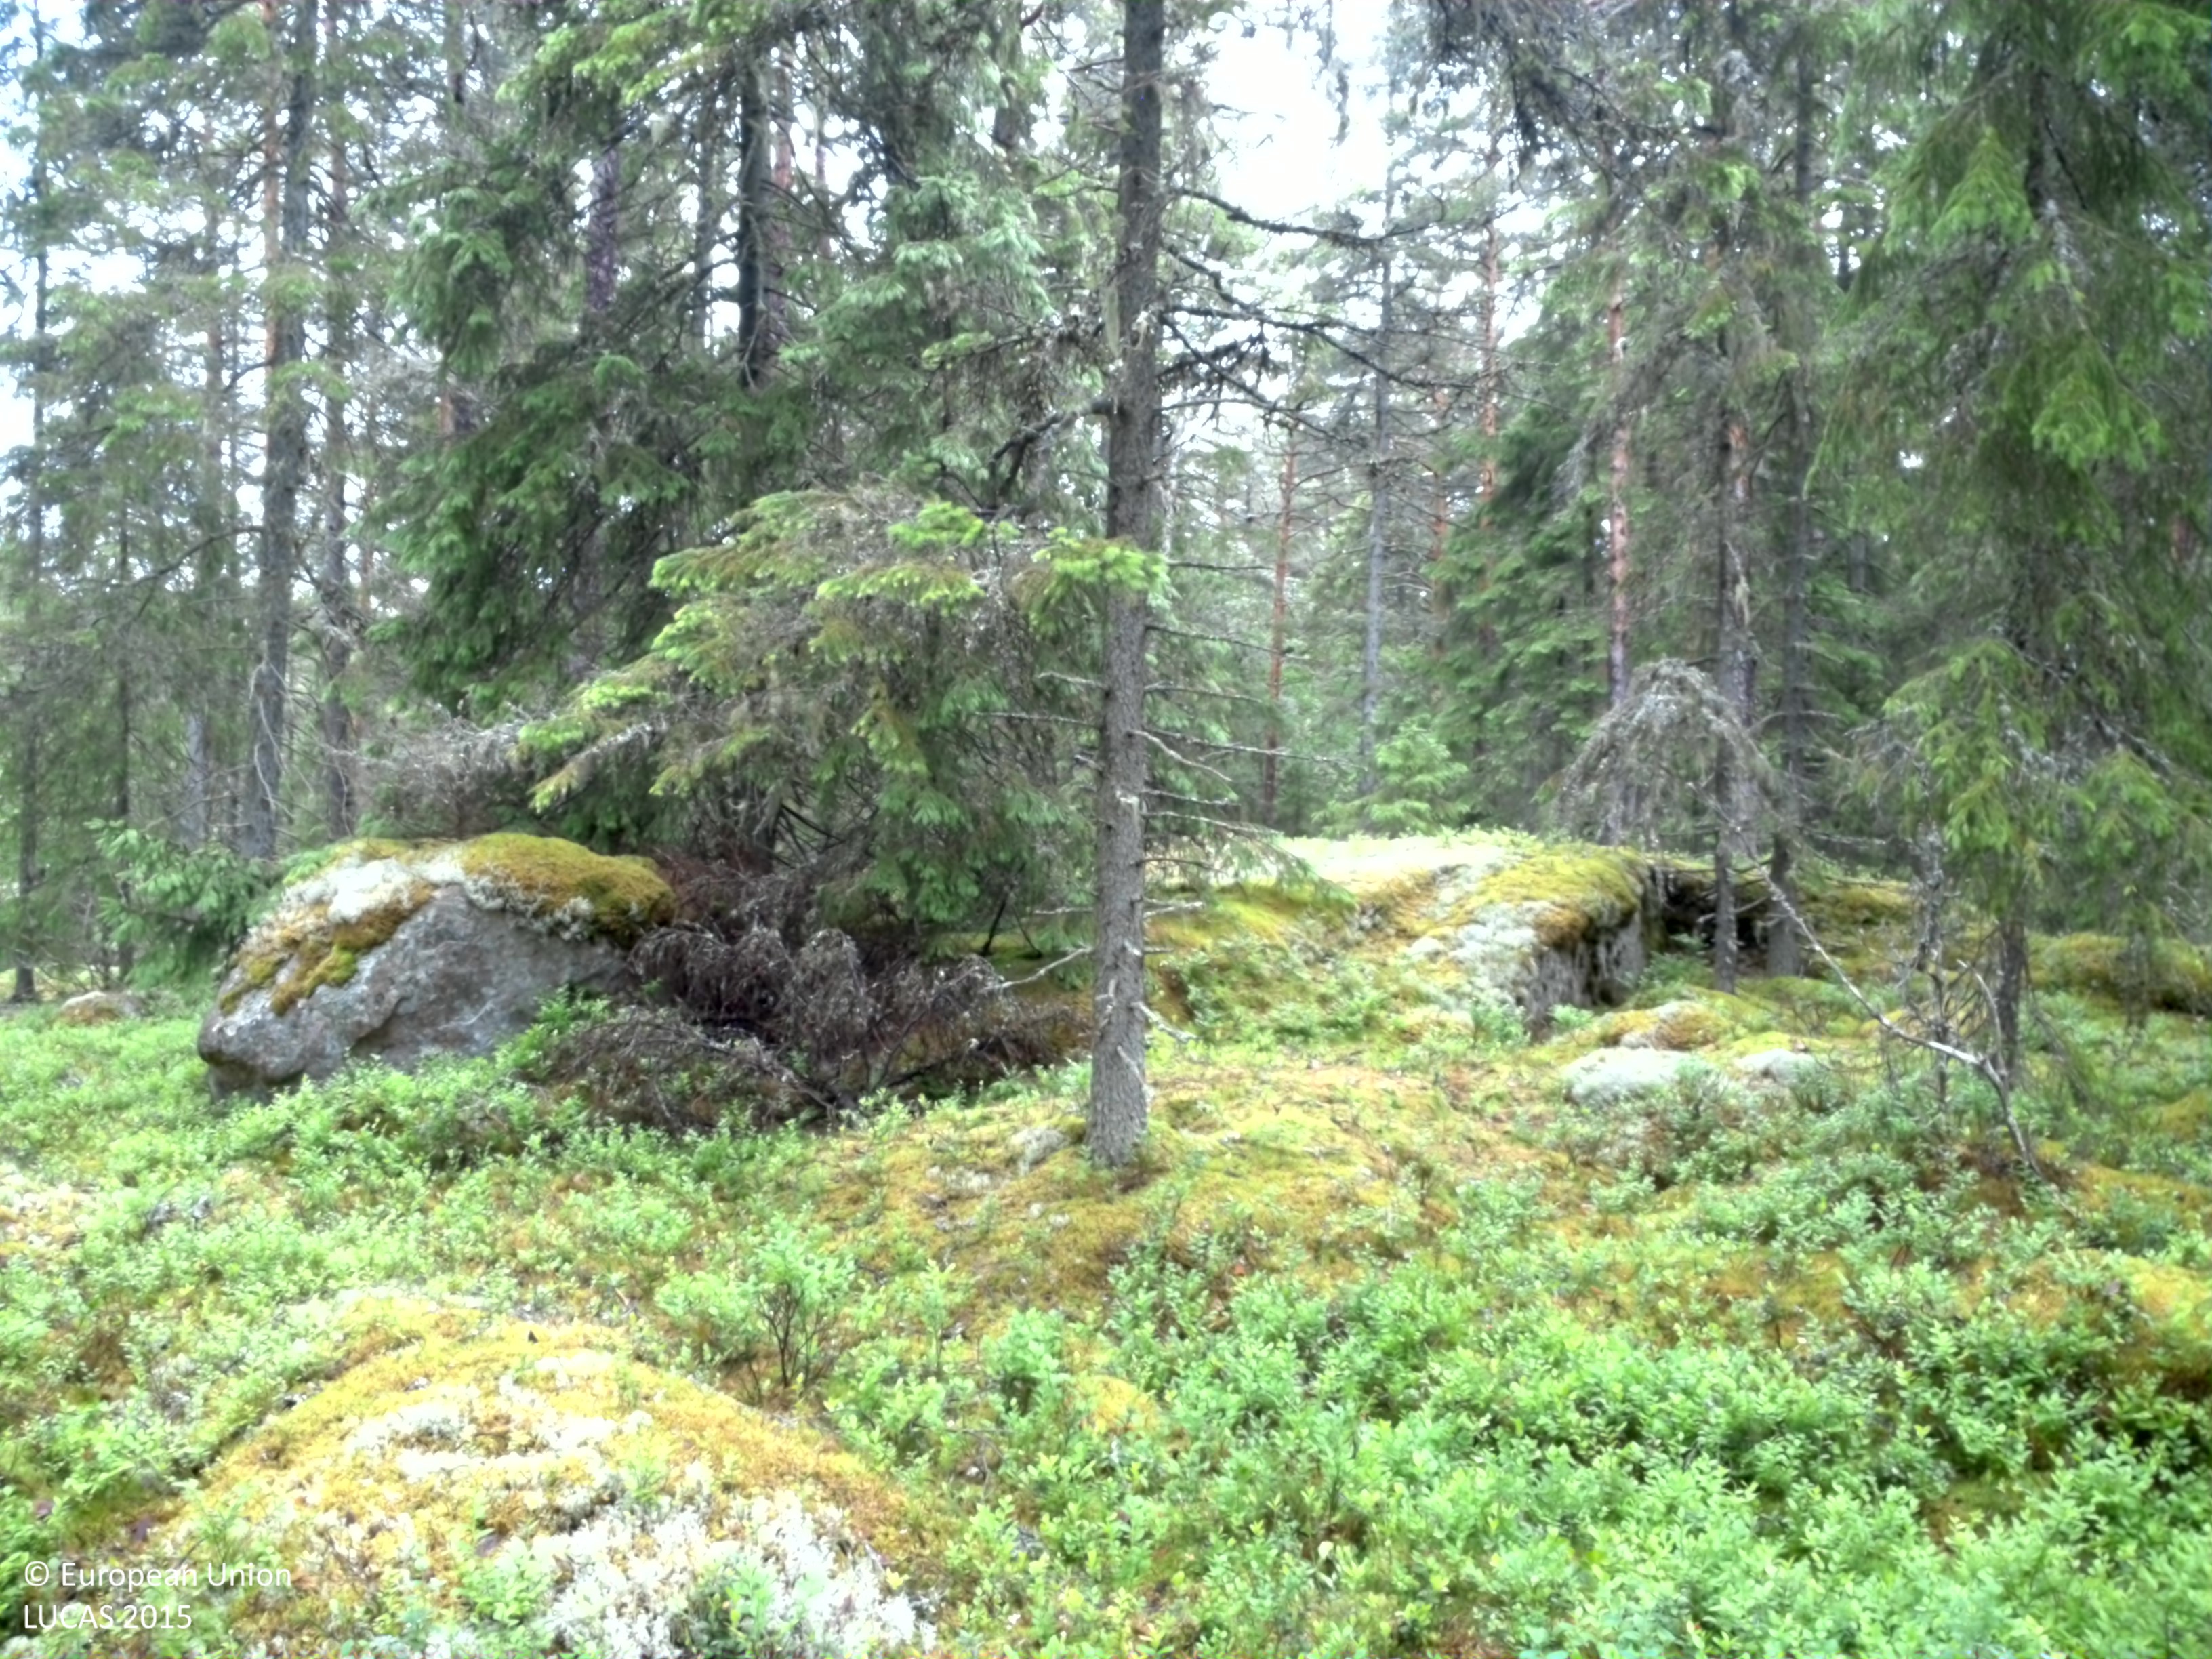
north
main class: Woodland
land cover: Pine dominated coniferous woodland
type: boreal forest
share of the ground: > 75 %
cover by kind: coniferous forest trees 80 %, broadleaved forest trees 10 %, lichens and mosses 10 %
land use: Amenities, museums, leisure
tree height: > 5 m
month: June
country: SE
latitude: 59.8366
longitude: 17.1476
